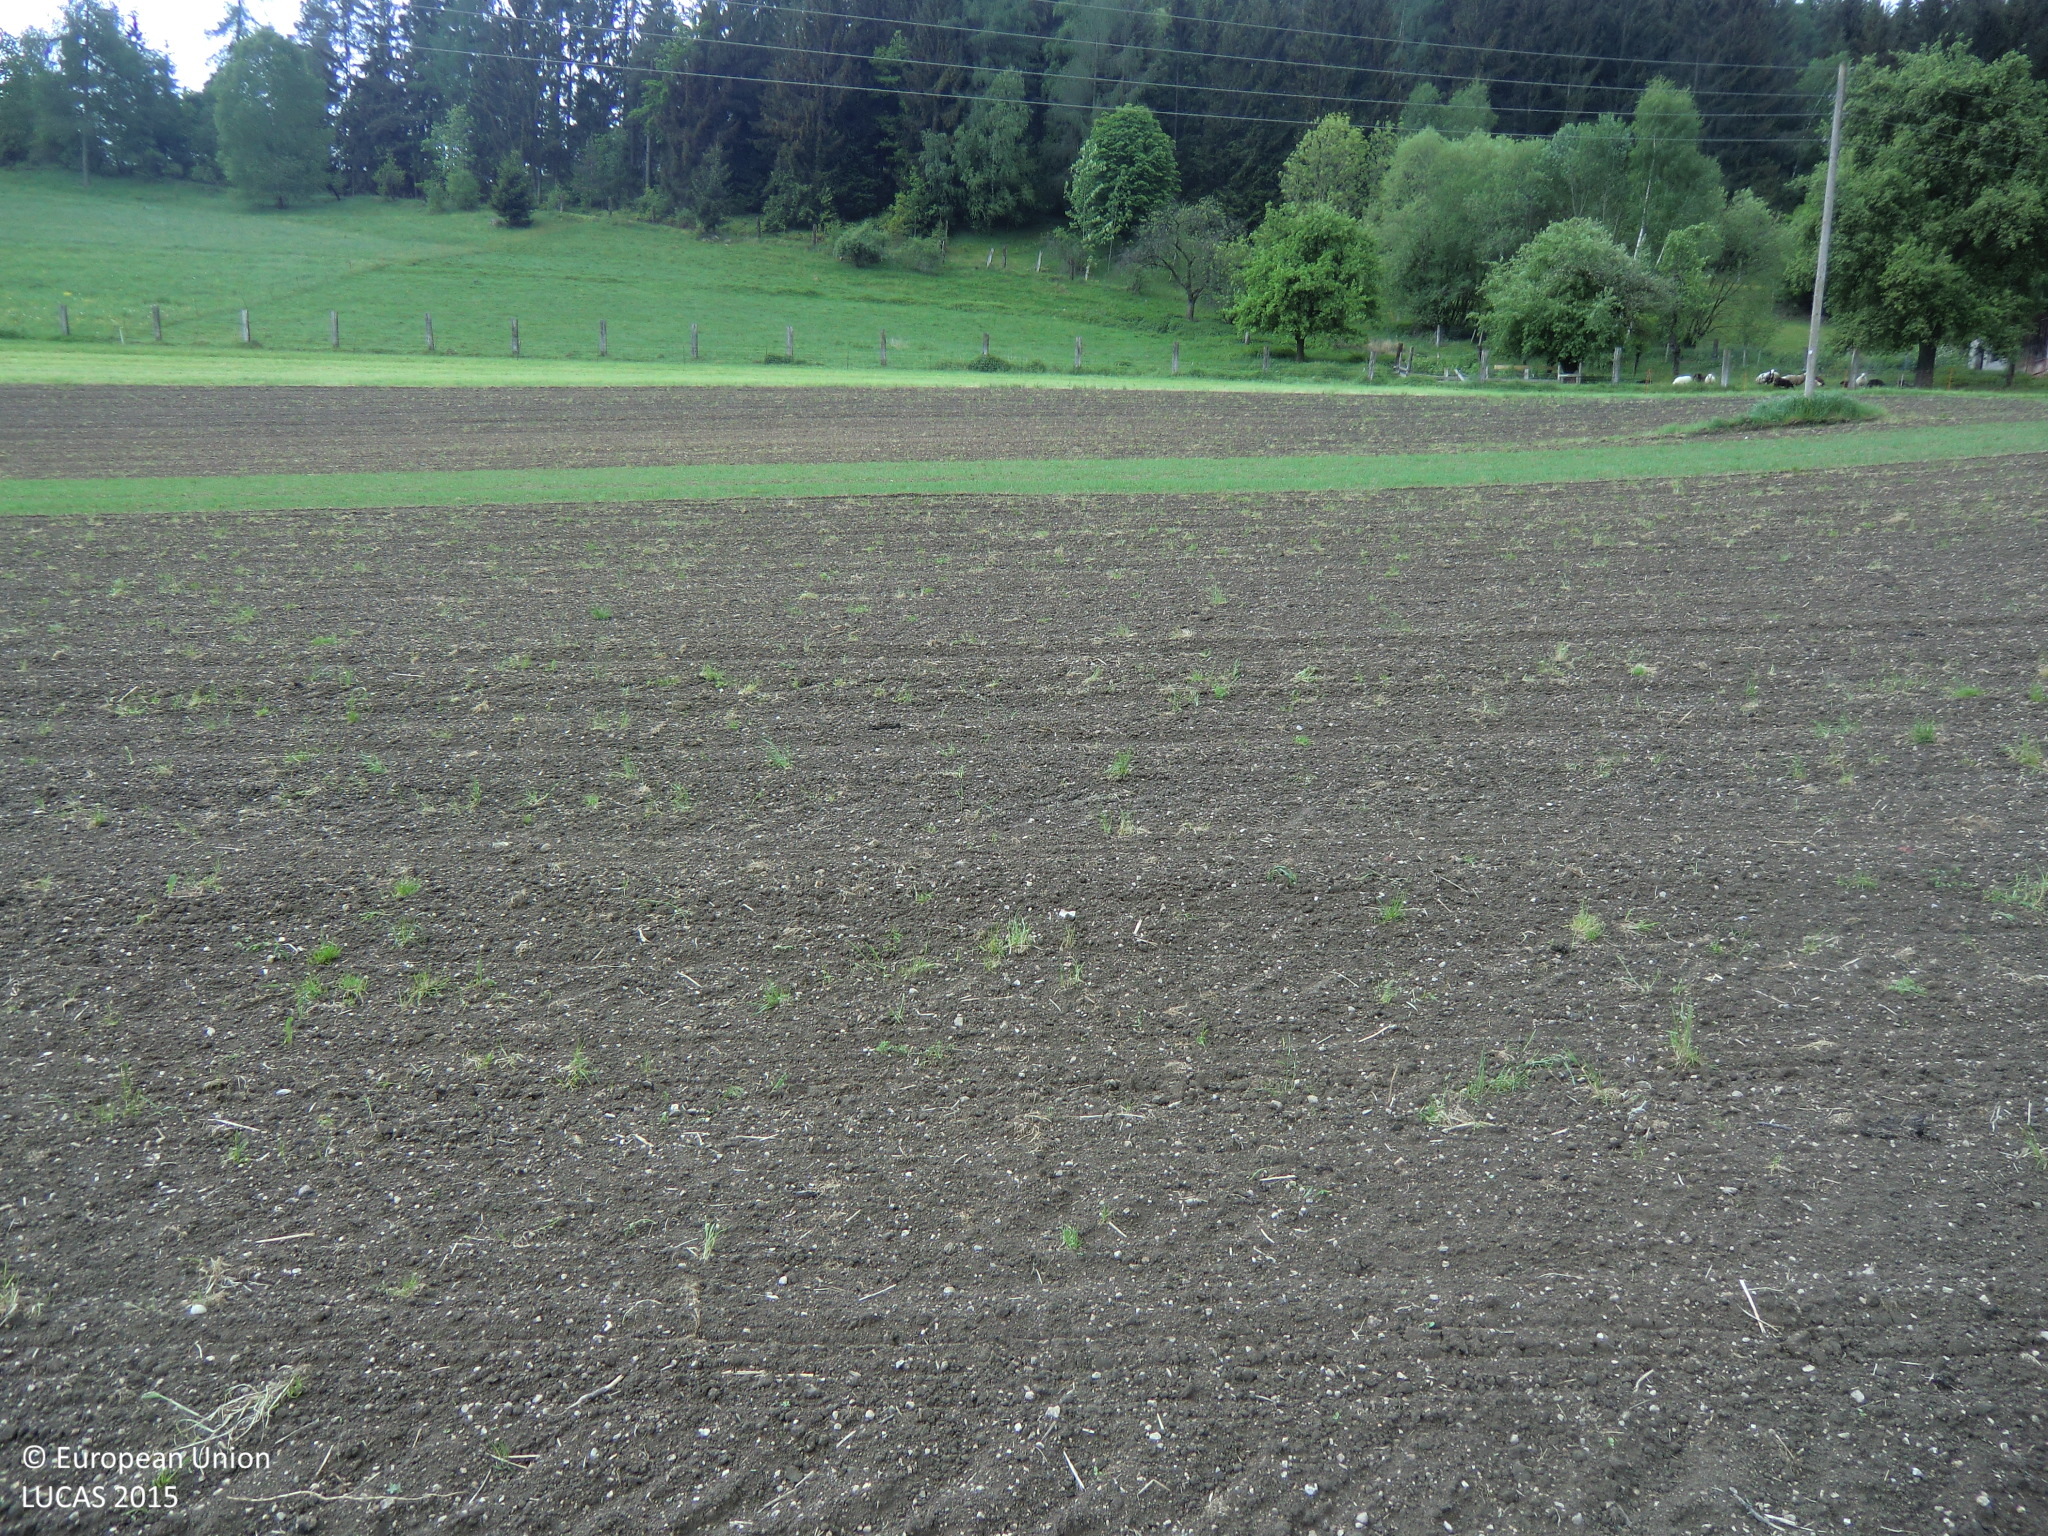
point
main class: Cropland
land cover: Maize
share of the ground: < 10 %
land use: Agriculture (excluding fallow land and kitchen gardens)
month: May
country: AT
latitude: 48.4761
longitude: 14.4511
